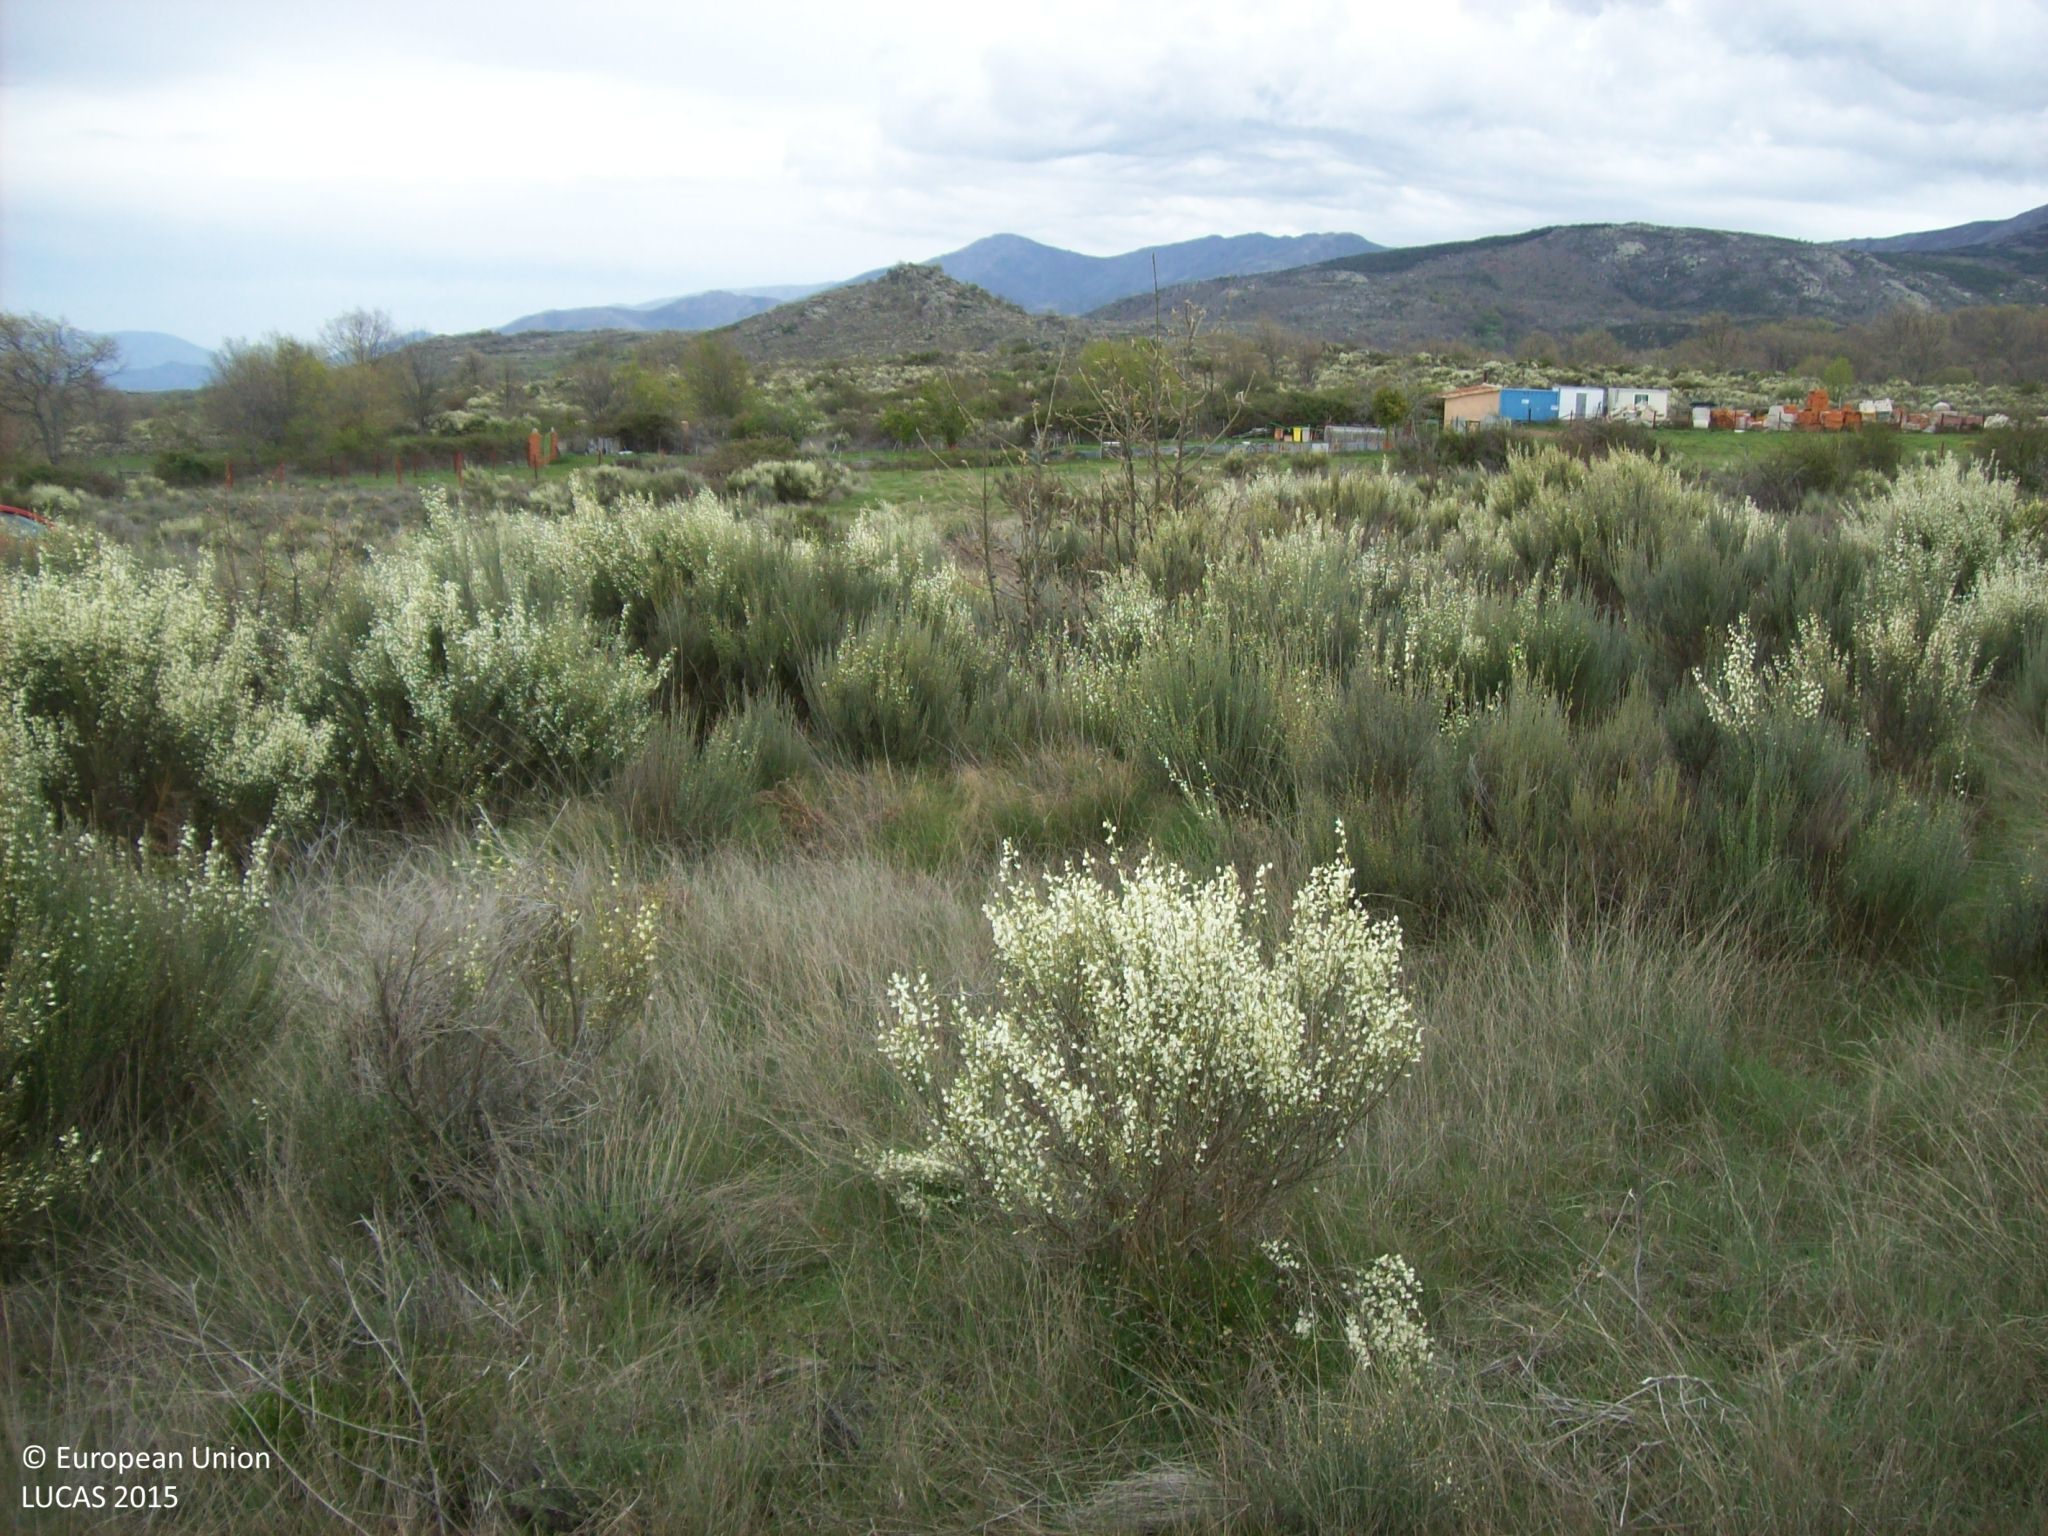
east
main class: Shrubland
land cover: Shrubland with sparse tree cover
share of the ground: > 75 %
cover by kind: shrubs 60 %, herbaceous plants 20 %, broadleaved forest trees 5 %
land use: Semi-natural and natural areas not in use
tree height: < 5 m
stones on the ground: < 10 %
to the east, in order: Shrubland with sparse tree cover; Tracks; Shrubland without tree cover; Tracks; Fences; Grassland without tree/shrub cover; Fences; Grassland with sparse tree/shrub cover; Fences; Grassland with sparse tree/shrub cover; Lines of trees; Shrubland without tree cover
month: April
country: ES
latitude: 40.3735
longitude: -4.8827
